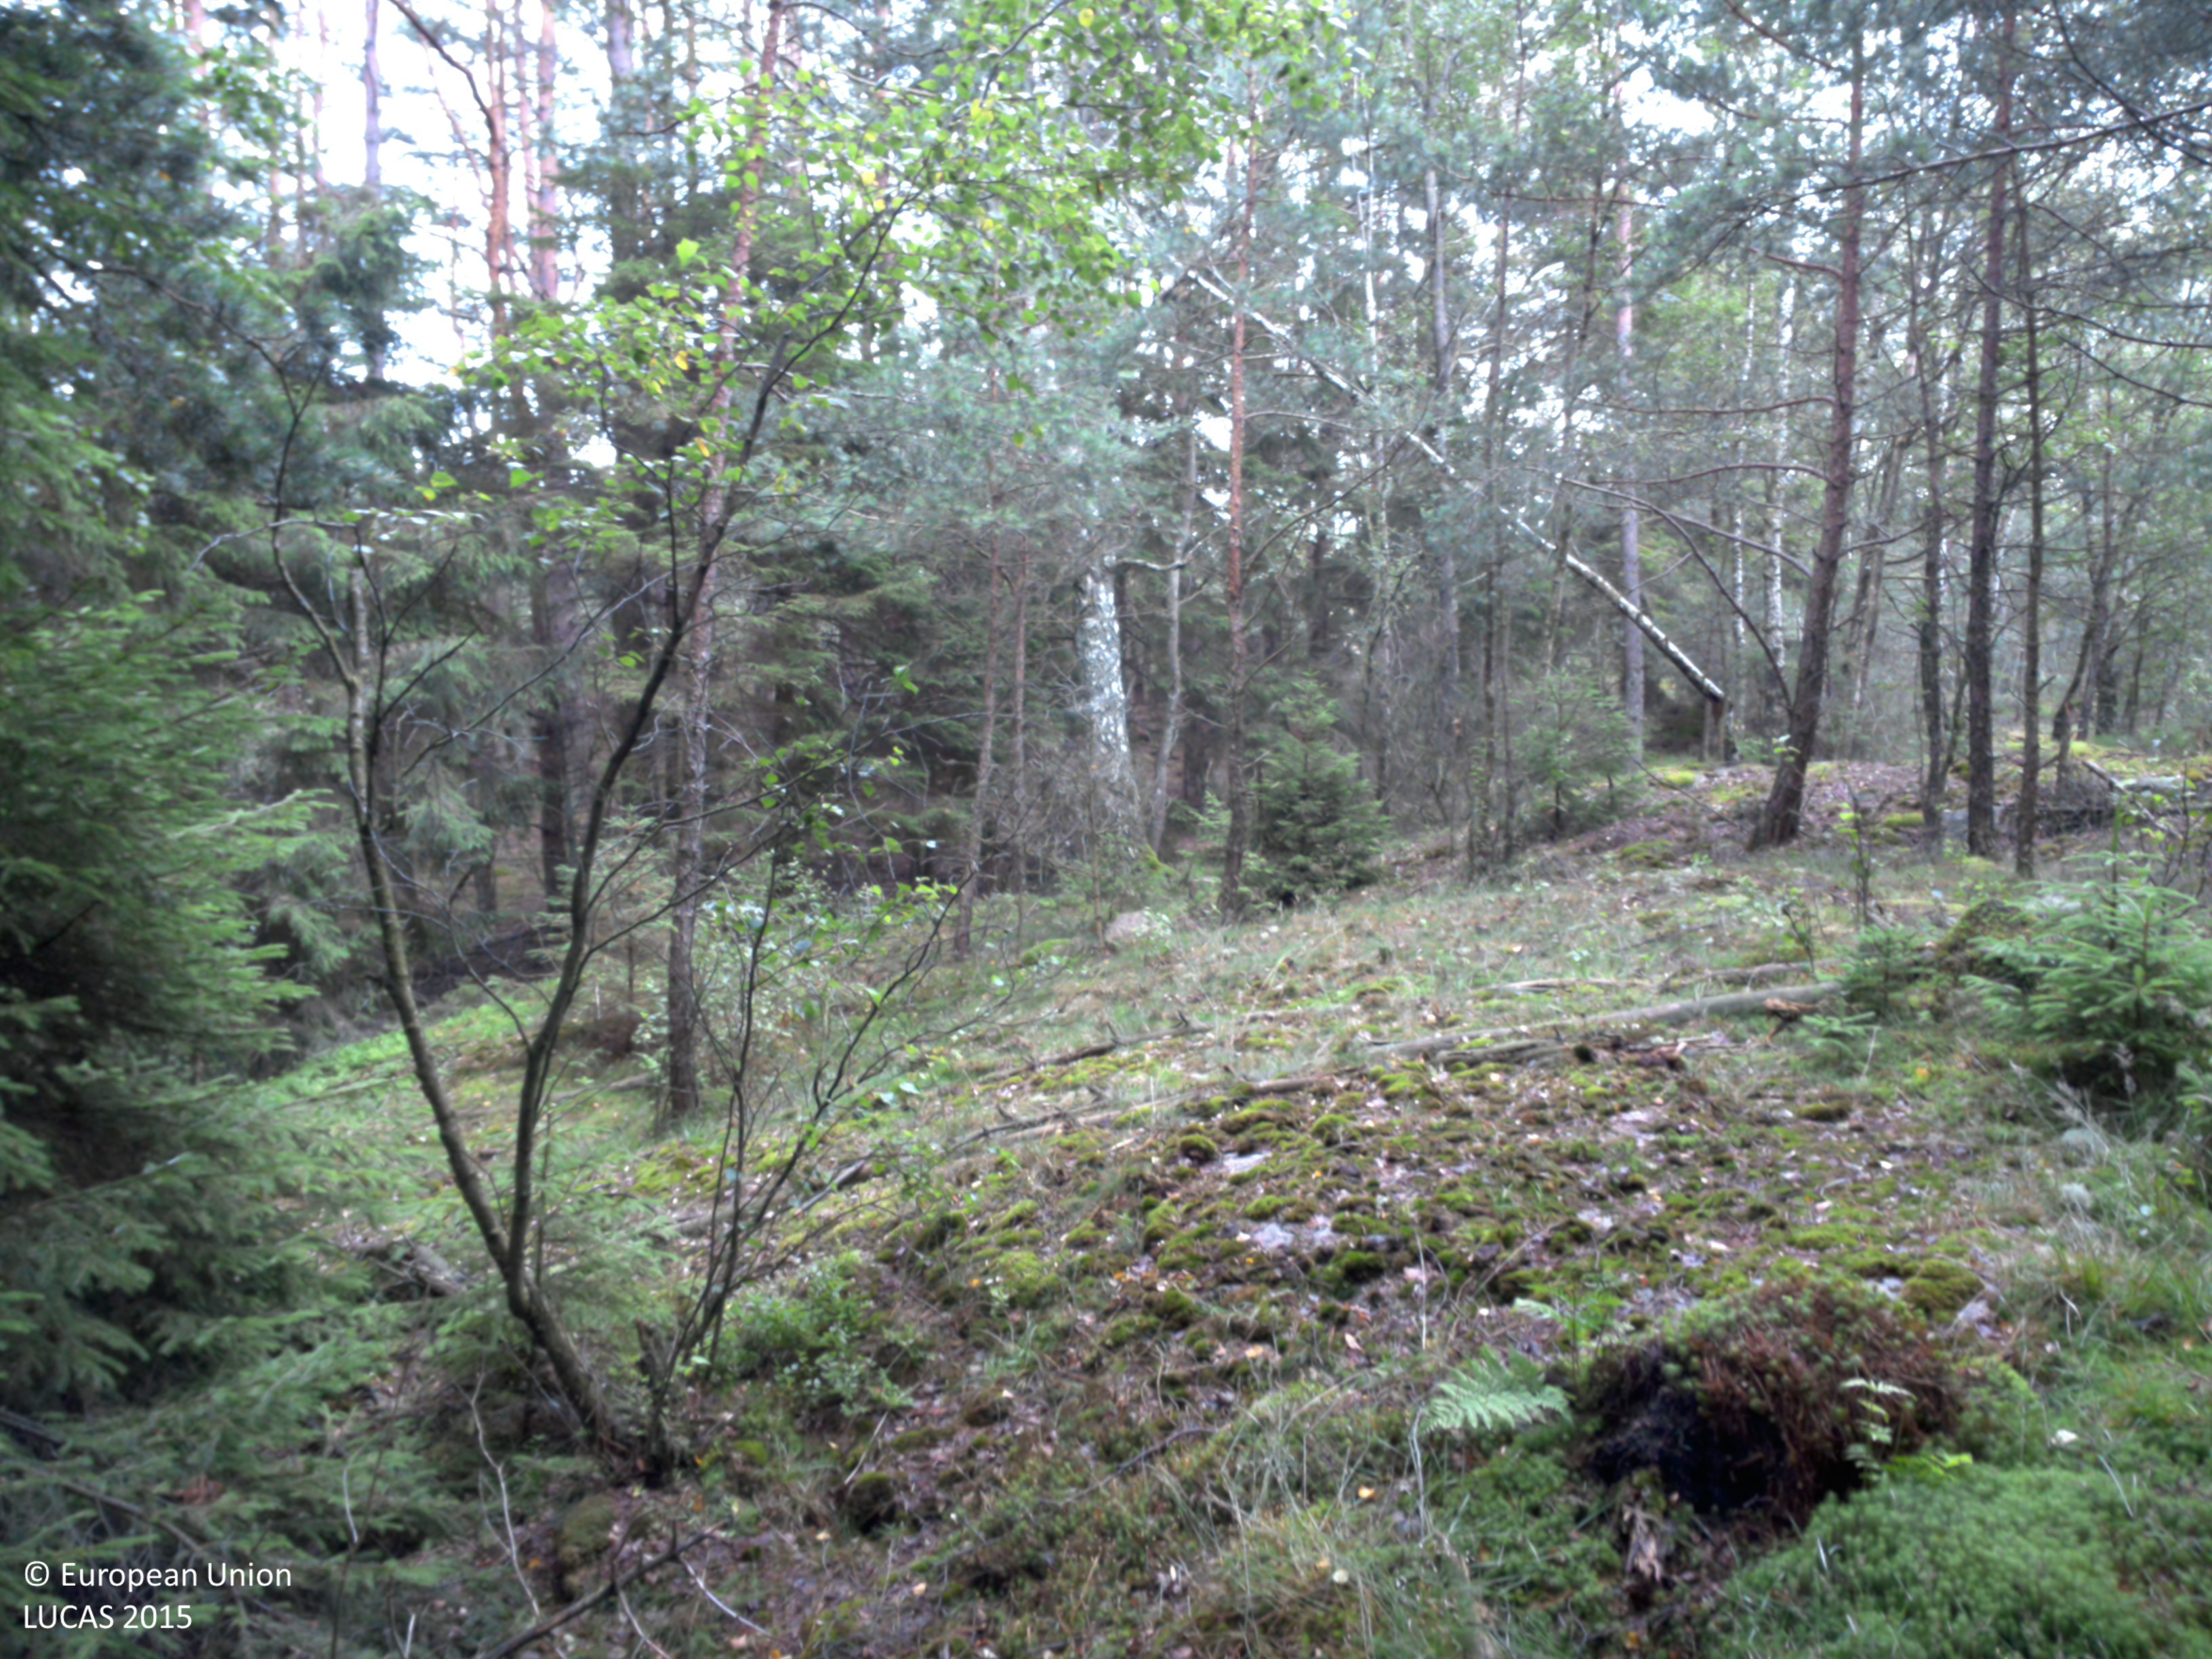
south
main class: Woodland
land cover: Spruce dominated mixed woodland
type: boreal forest
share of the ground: 50 - 75 %
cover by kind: coniferous forest trees 50 %, broadleaved forest trees 20 %, lichens and mosses 20 %, herbaceous plants 10 %
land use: Forestry
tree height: > 5 m
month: July
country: SE
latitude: 58.0116
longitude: 11.6386
